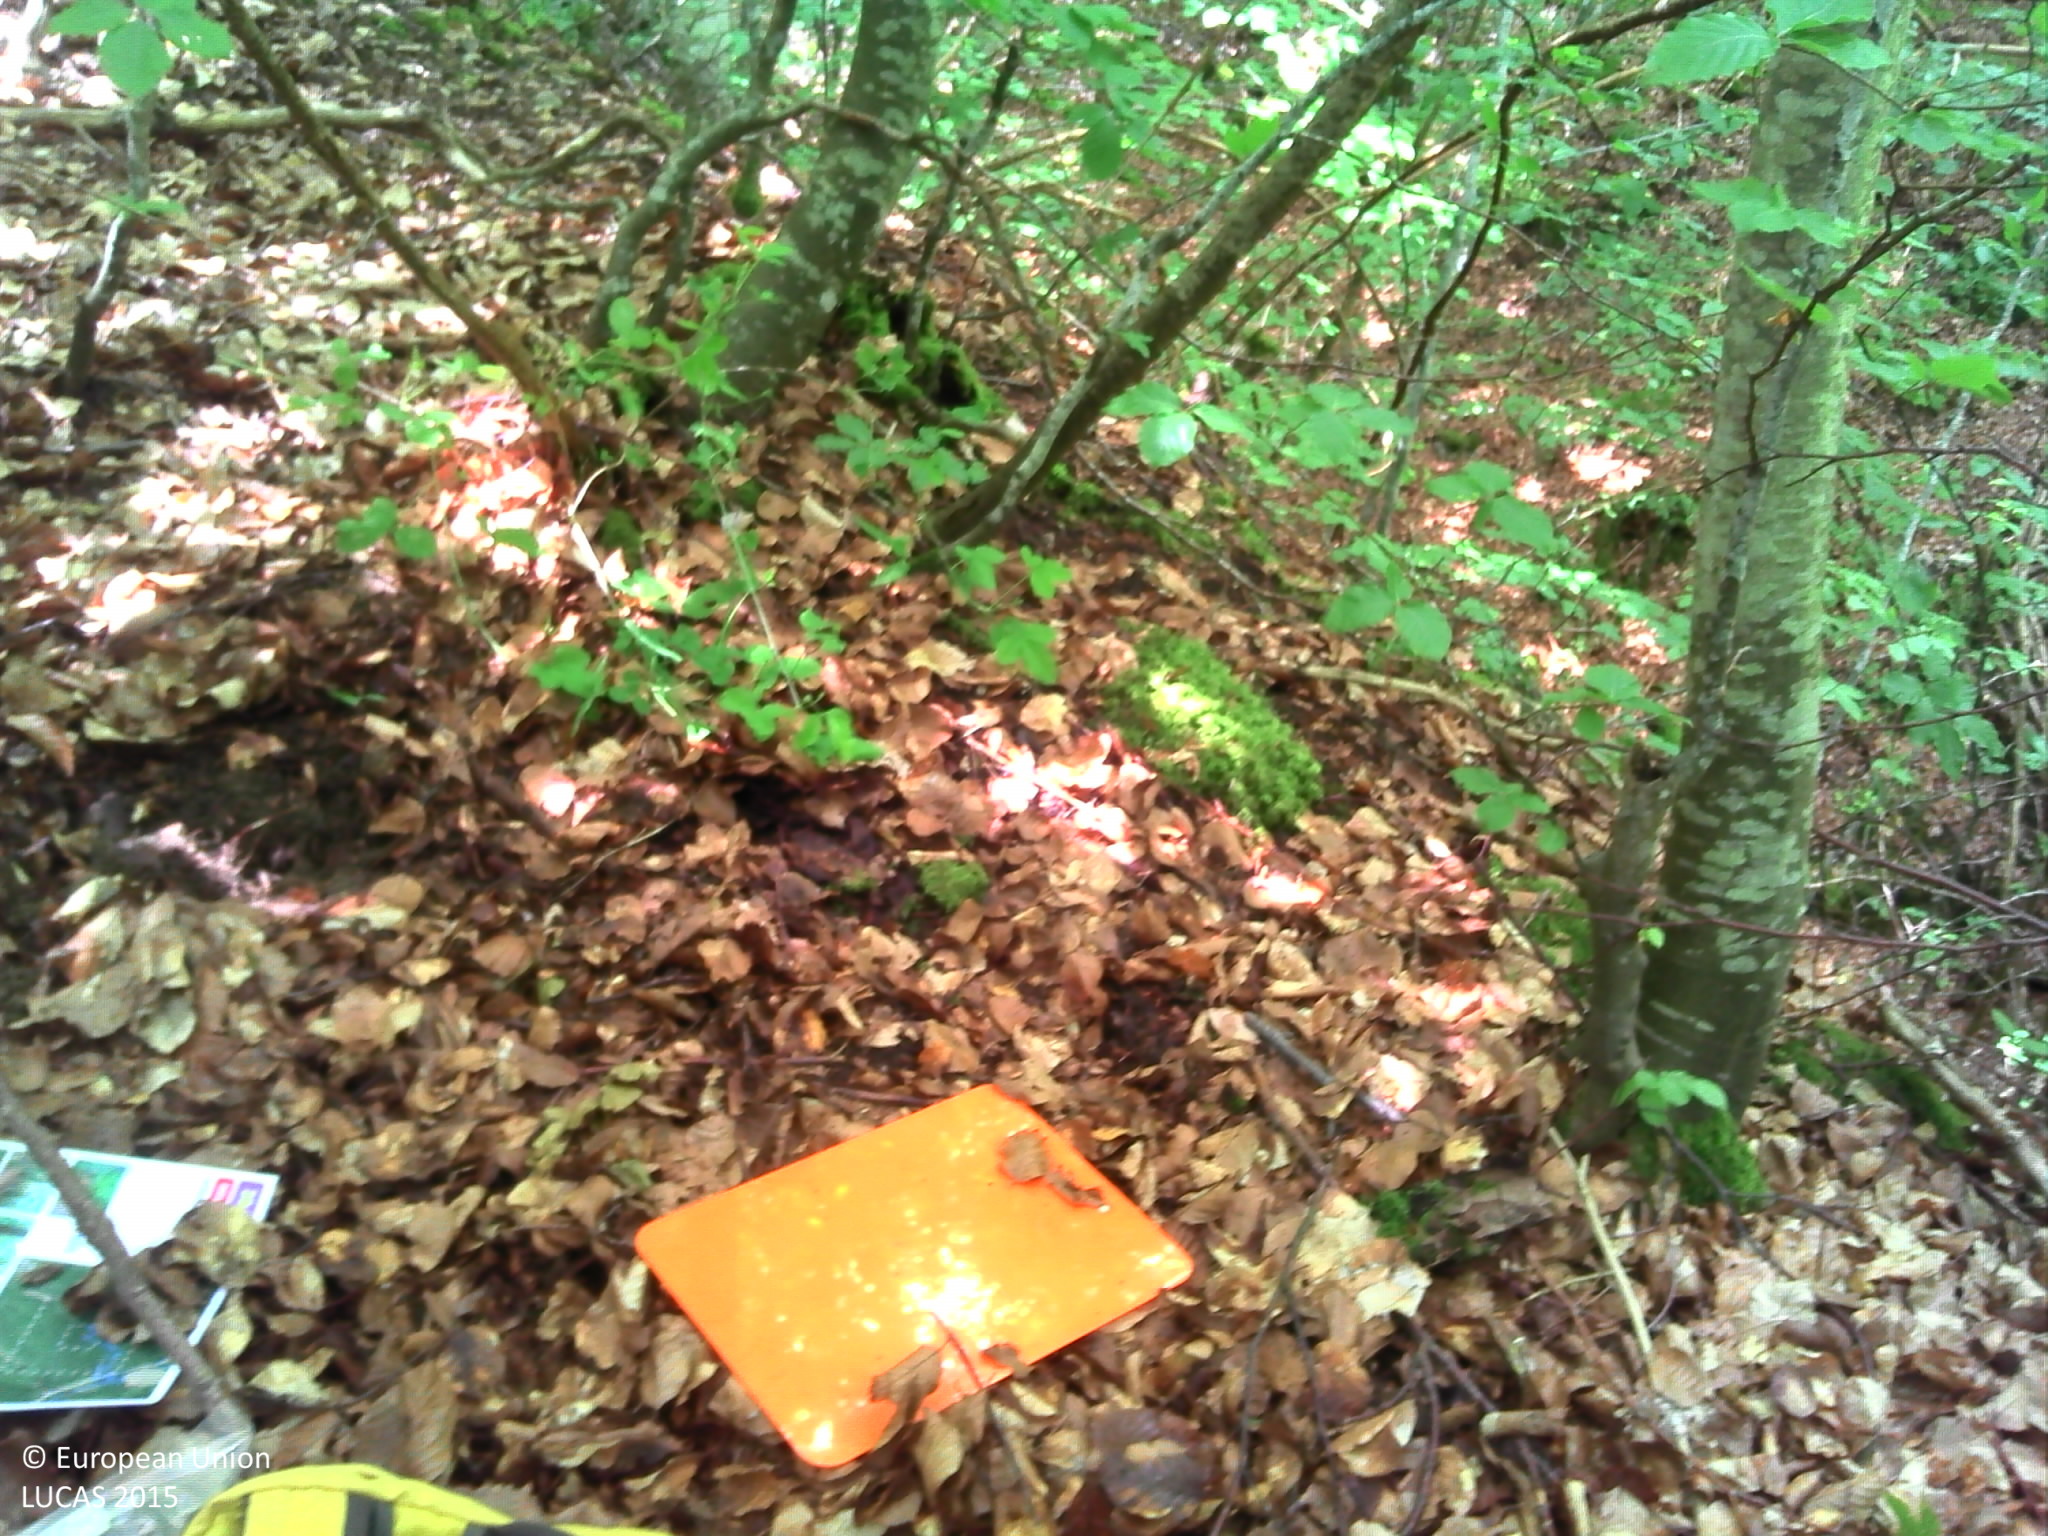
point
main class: Woodland
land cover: Broadleaved woodland
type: beech forest
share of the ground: > 75 %
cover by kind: broadleaved forest trees 95 %, lichens and mosses 5 %
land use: Forestry
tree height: > 5 m
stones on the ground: < 10 %
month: June
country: FR
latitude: 44.6551
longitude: 5.2020
